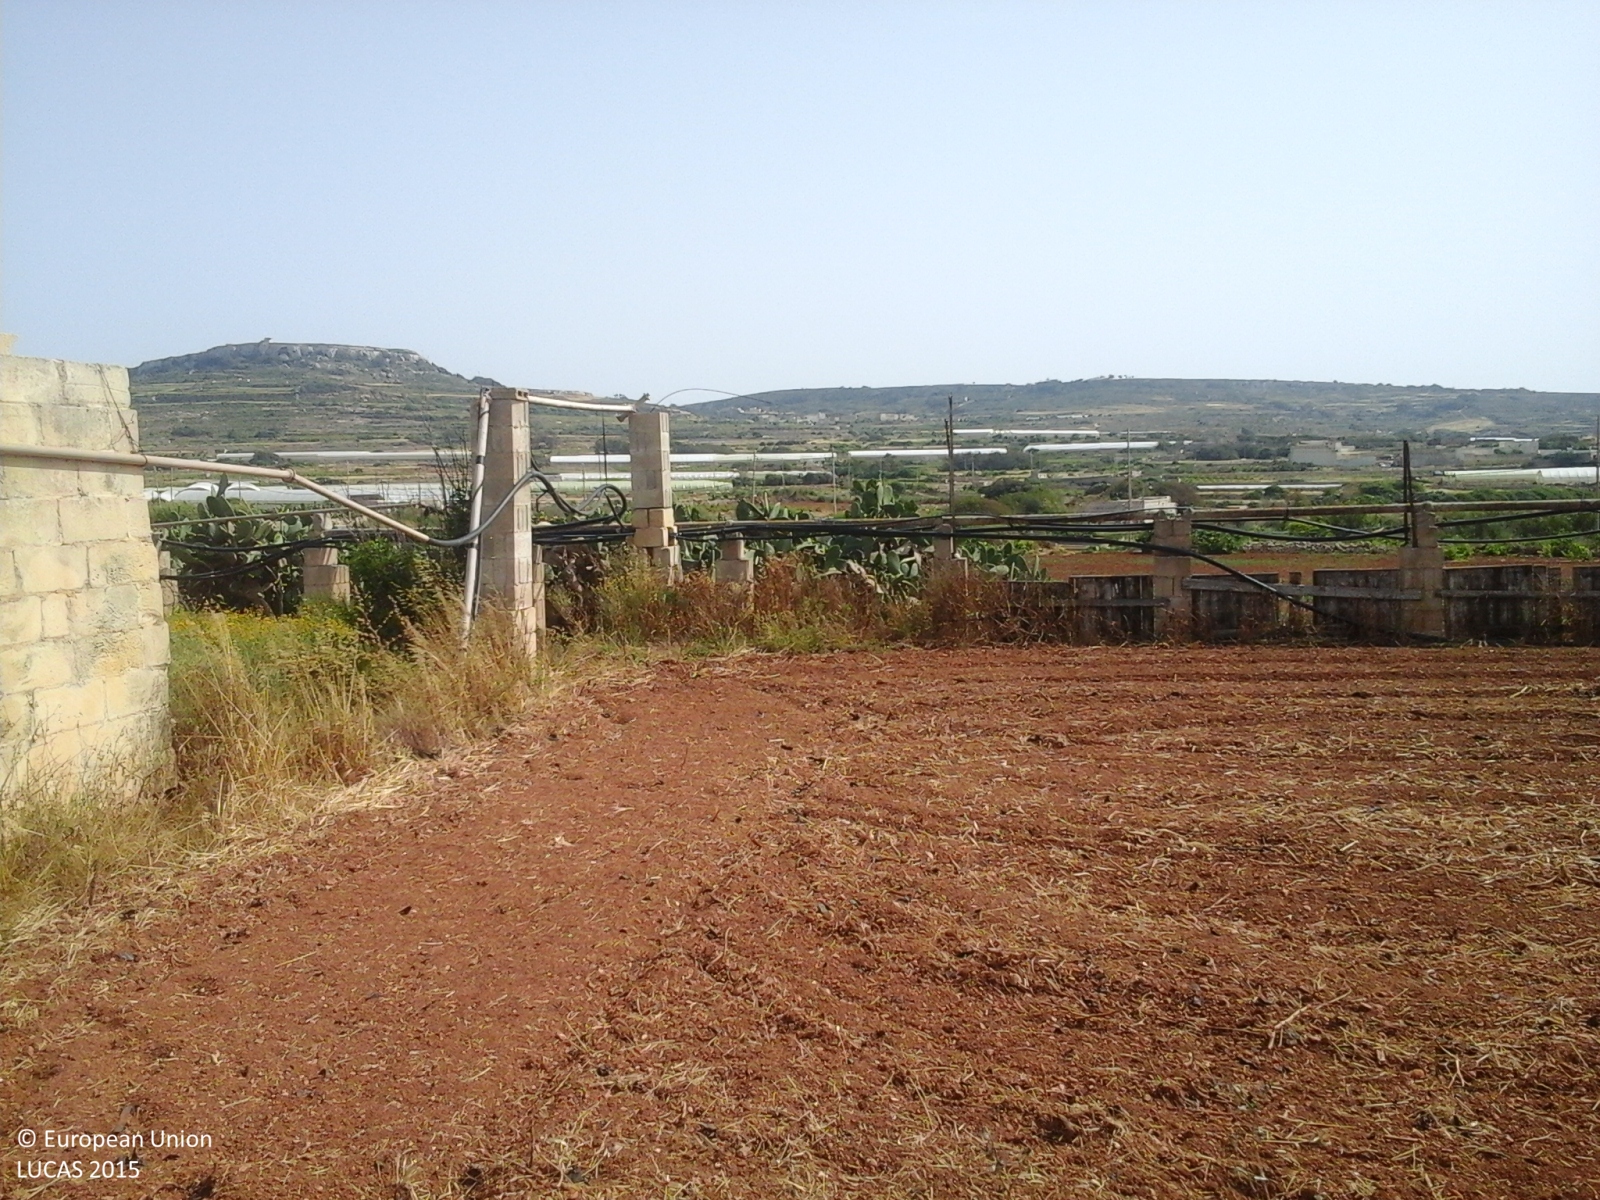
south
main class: Grassland
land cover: Spontaneously vegetated surfaces
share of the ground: 25 - 50 %
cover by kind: herbaceous plants 50 %, unconsolidated bare surface 30 %
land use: Agriculture (excluding fallow land and kitchen gardens)
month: May
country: MT
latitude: 35.9189
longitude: 14.3593
